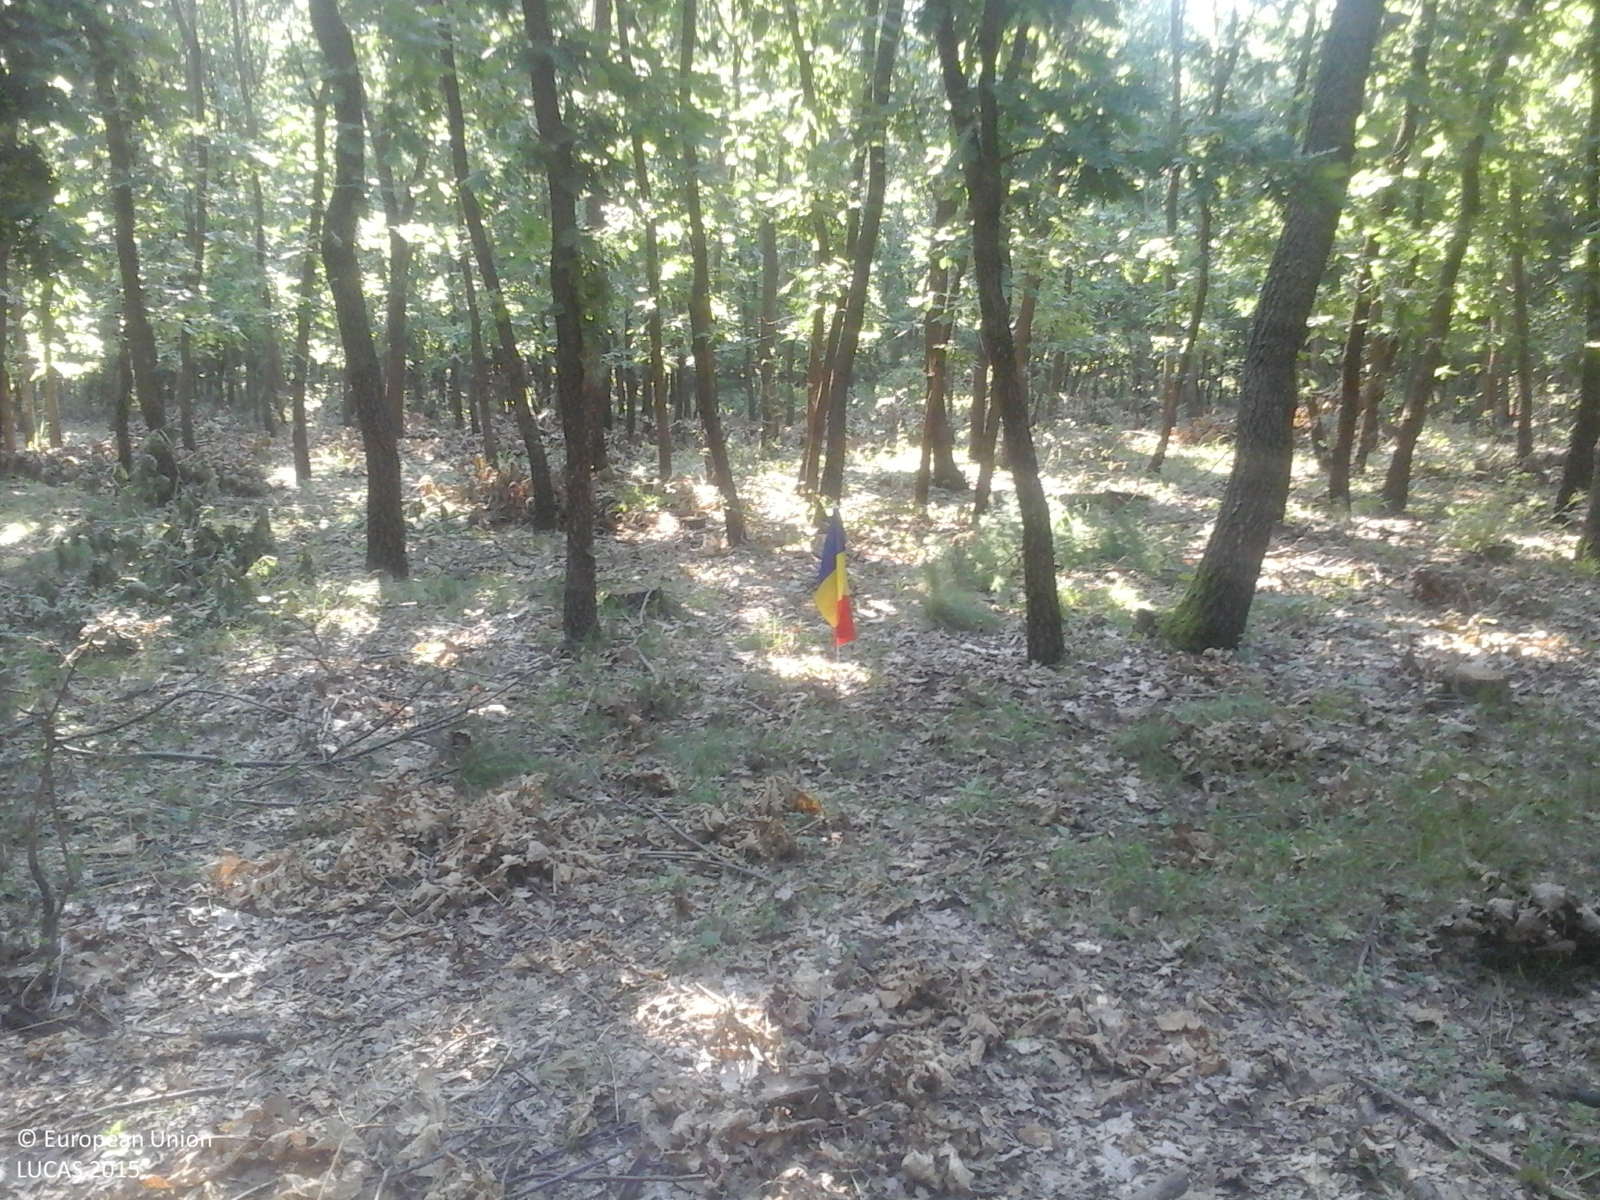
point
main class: Woodland
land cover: Broadleaved woodland
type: acidophilous oak and oak-birch forest
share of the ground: > 75 %
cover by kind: broadleaved forest trees 100 %
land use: Forestry
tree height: > 5 m
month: July
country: RO
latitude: 44.5258
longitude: 24.8116
